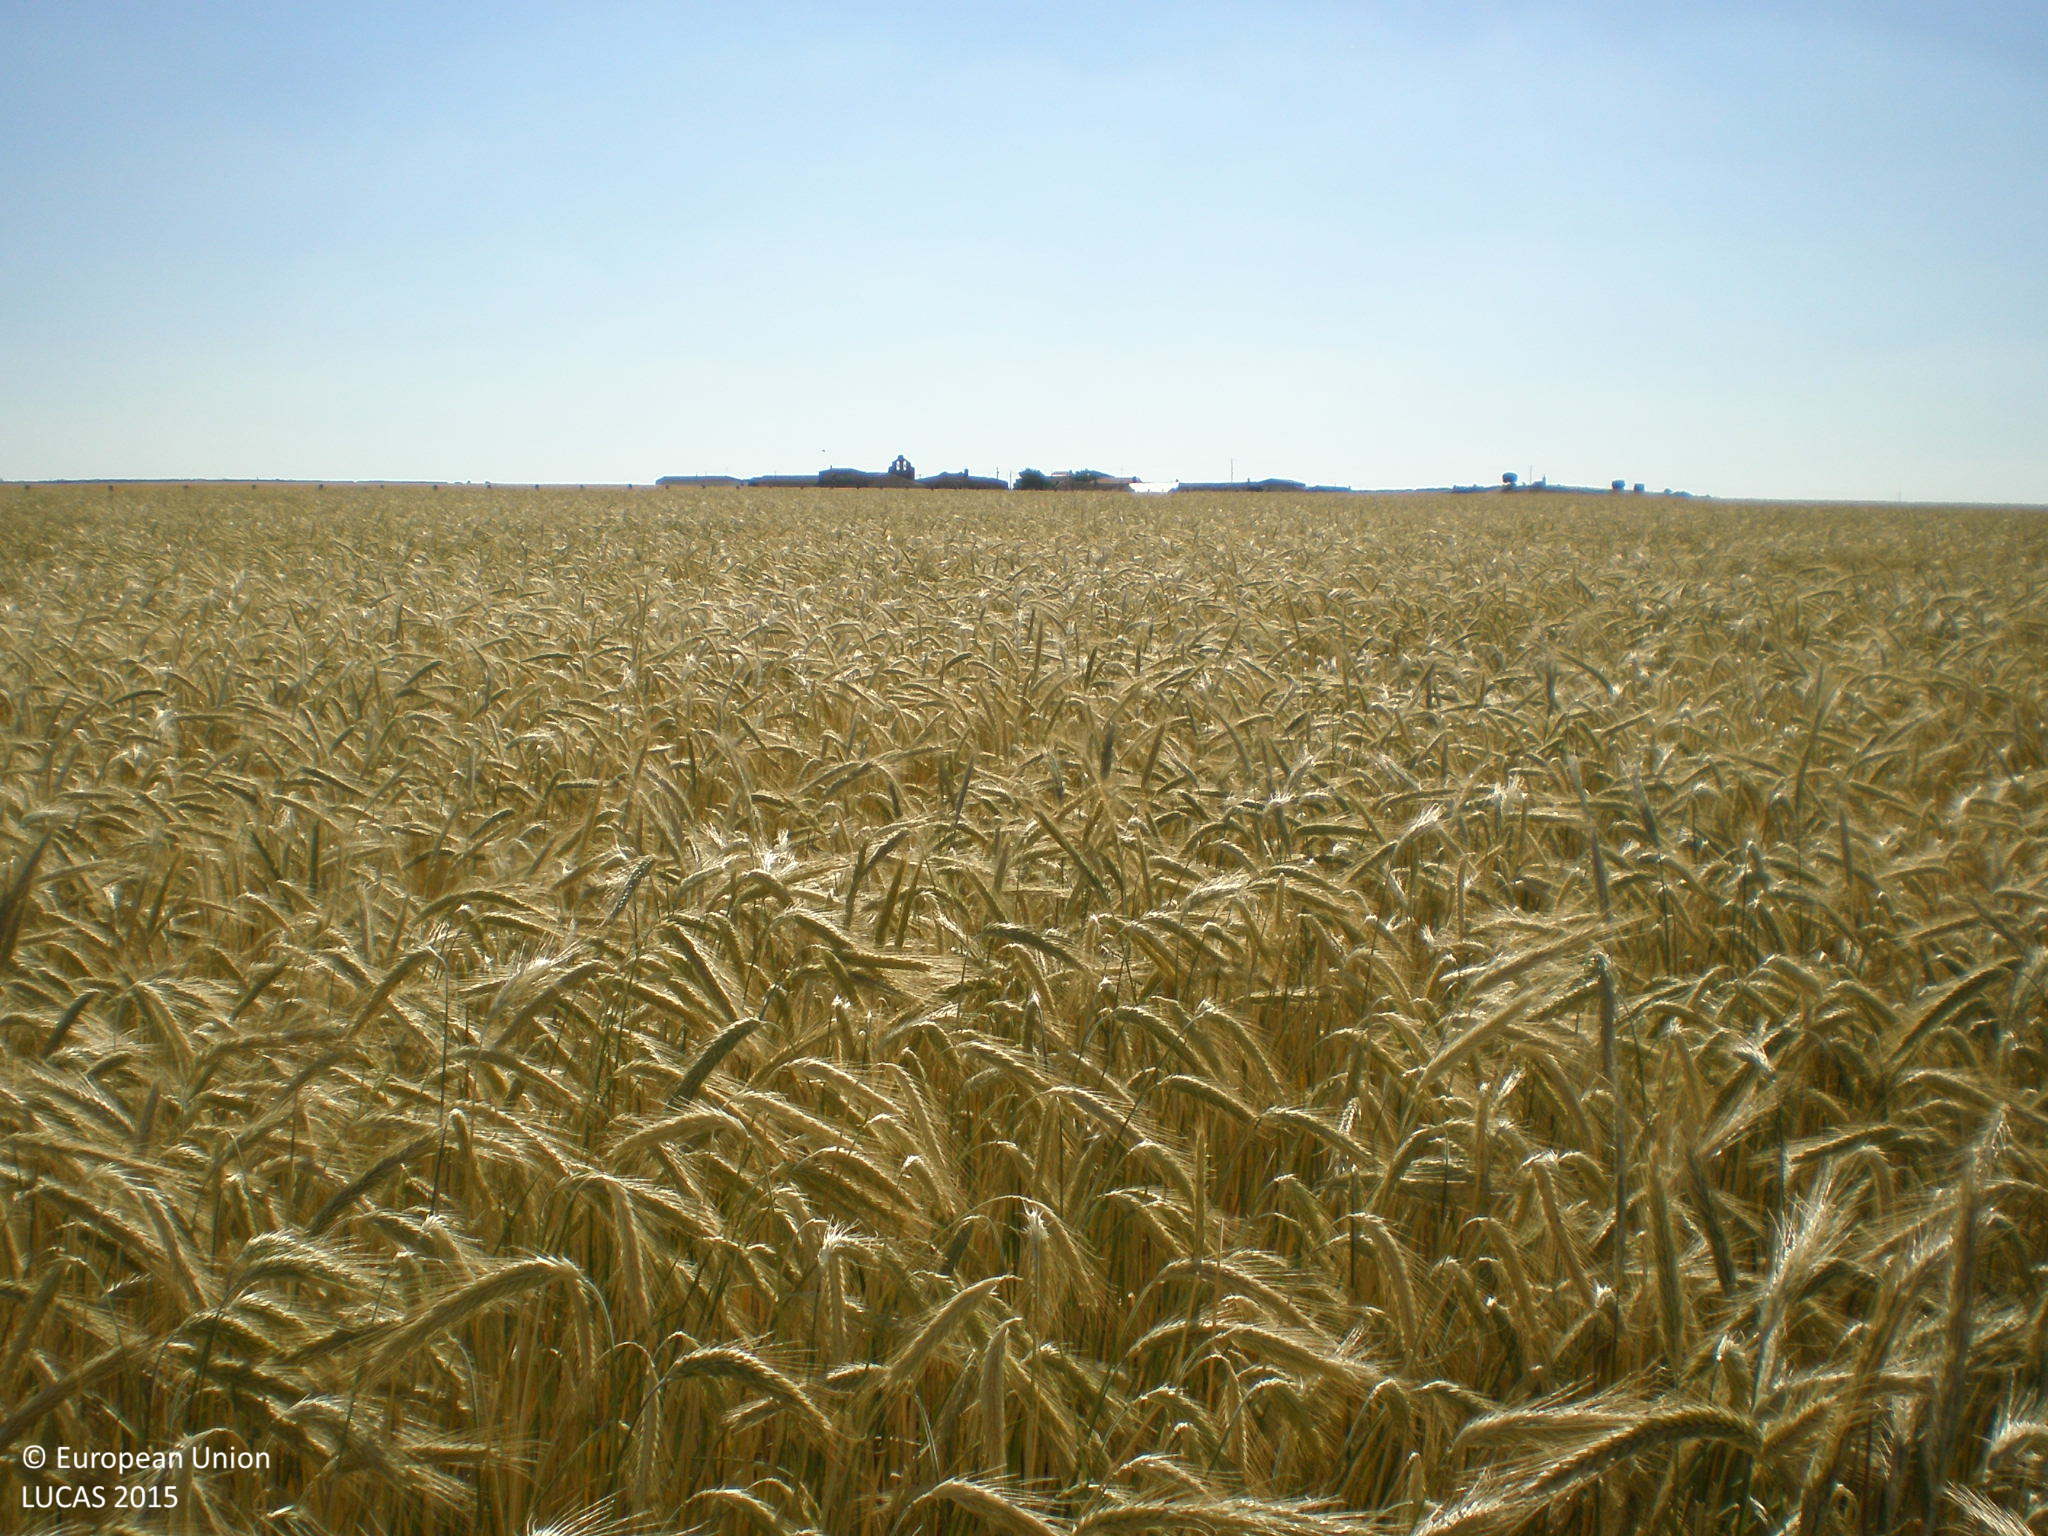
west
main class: Cropland
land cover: Rye
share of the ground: > 75 %
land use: Agriculture (excluding fallow land and kitchen gardens)
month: June
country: ES
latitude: 40.8478
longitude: -5.7217
